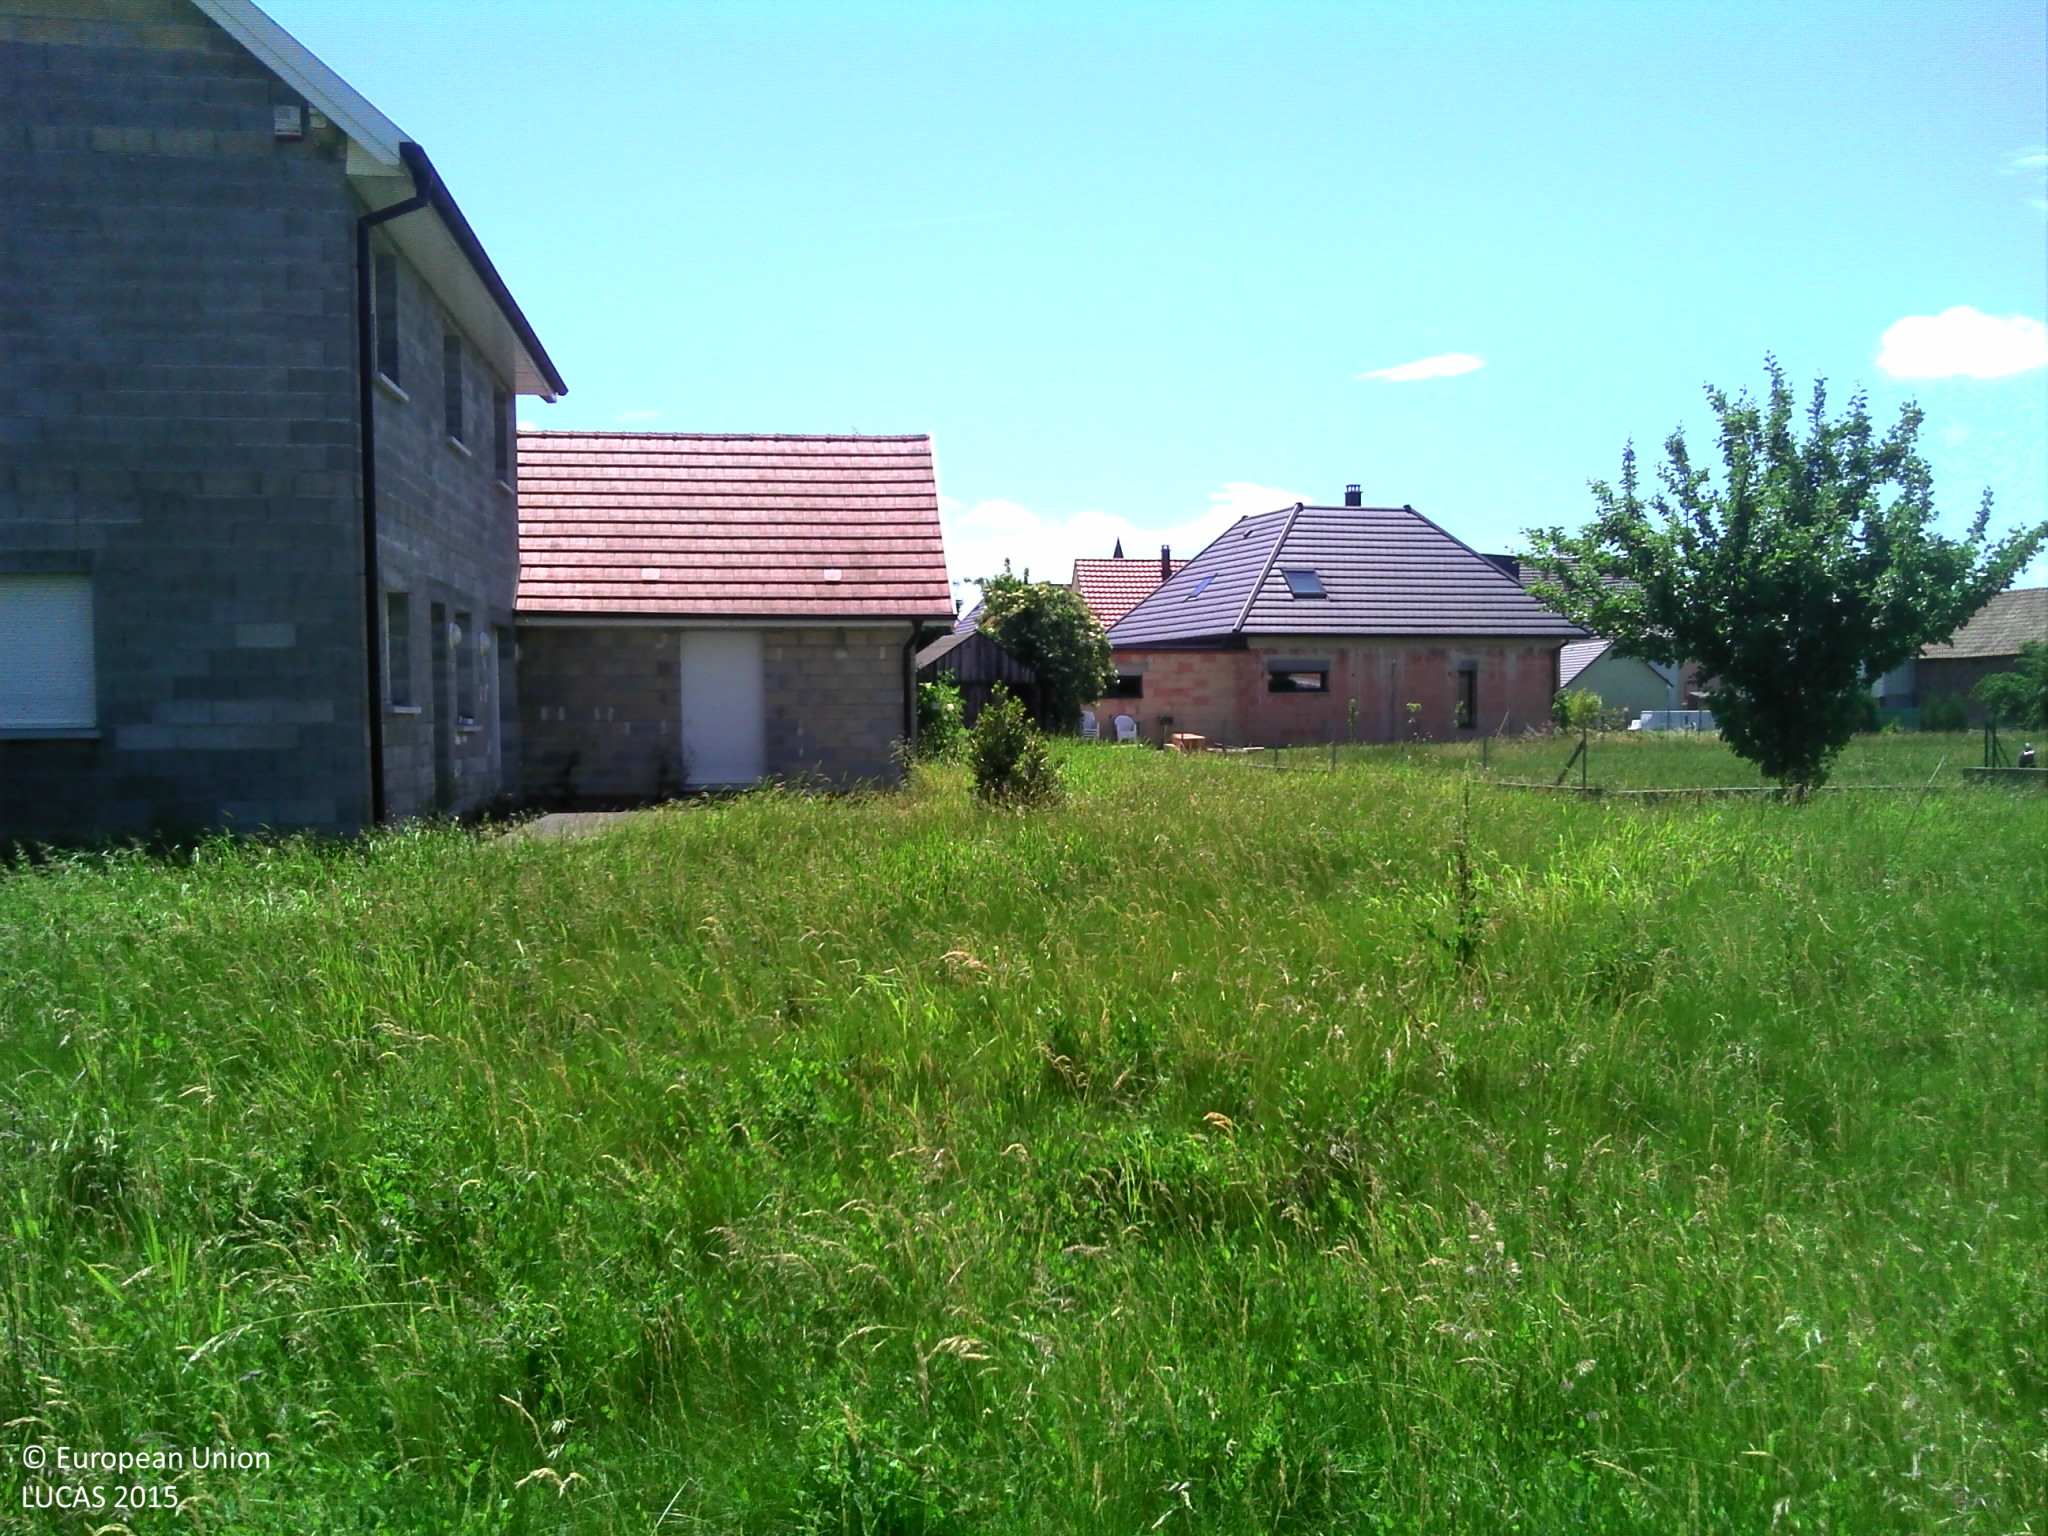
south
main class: Grassland
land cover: Grassland with sparse tree/shrub cover
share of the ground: > 75 %
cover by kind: herbaceous plants 95 %, broadleaved forest trees 5 %
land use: Residential
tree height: < 5 m
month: June
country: FR
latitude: 47.9586
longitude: 7.3898
